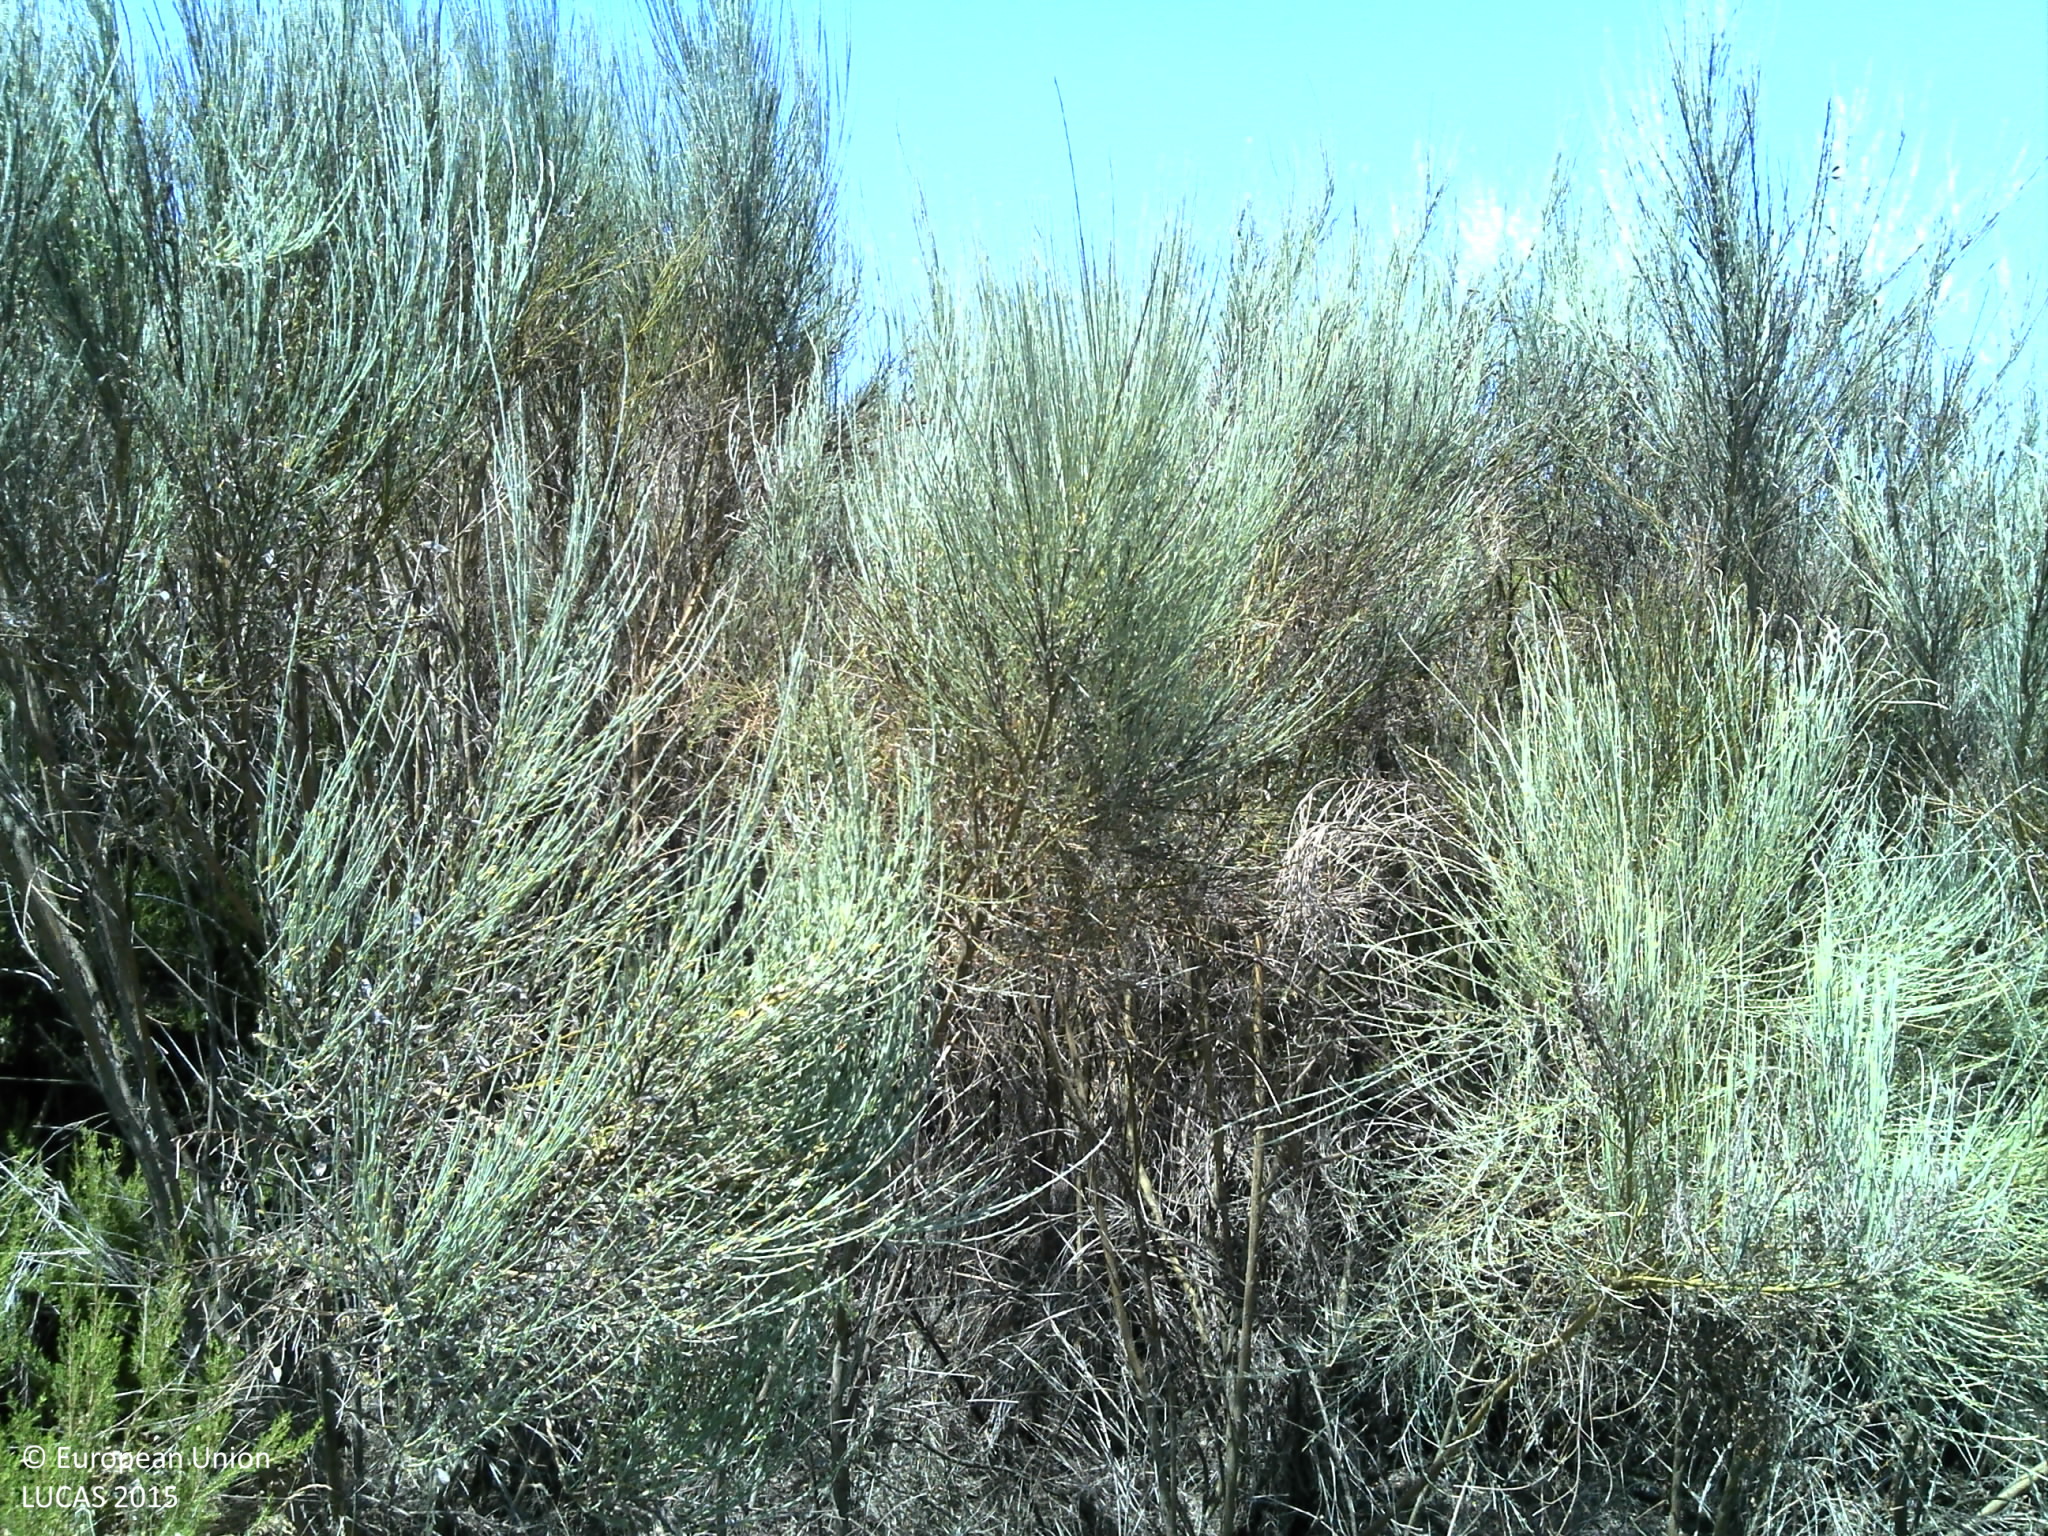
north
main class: Shrubland
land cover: Shrubland without tree cover
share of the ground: > 75 %
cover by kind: shrubs 90 %, herbaceous plants 5 %, consolidated bare surface 5 %
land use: Semi-natural and natural areas not in use
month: July
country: PT
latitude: 40.8455
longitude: -7.4683
